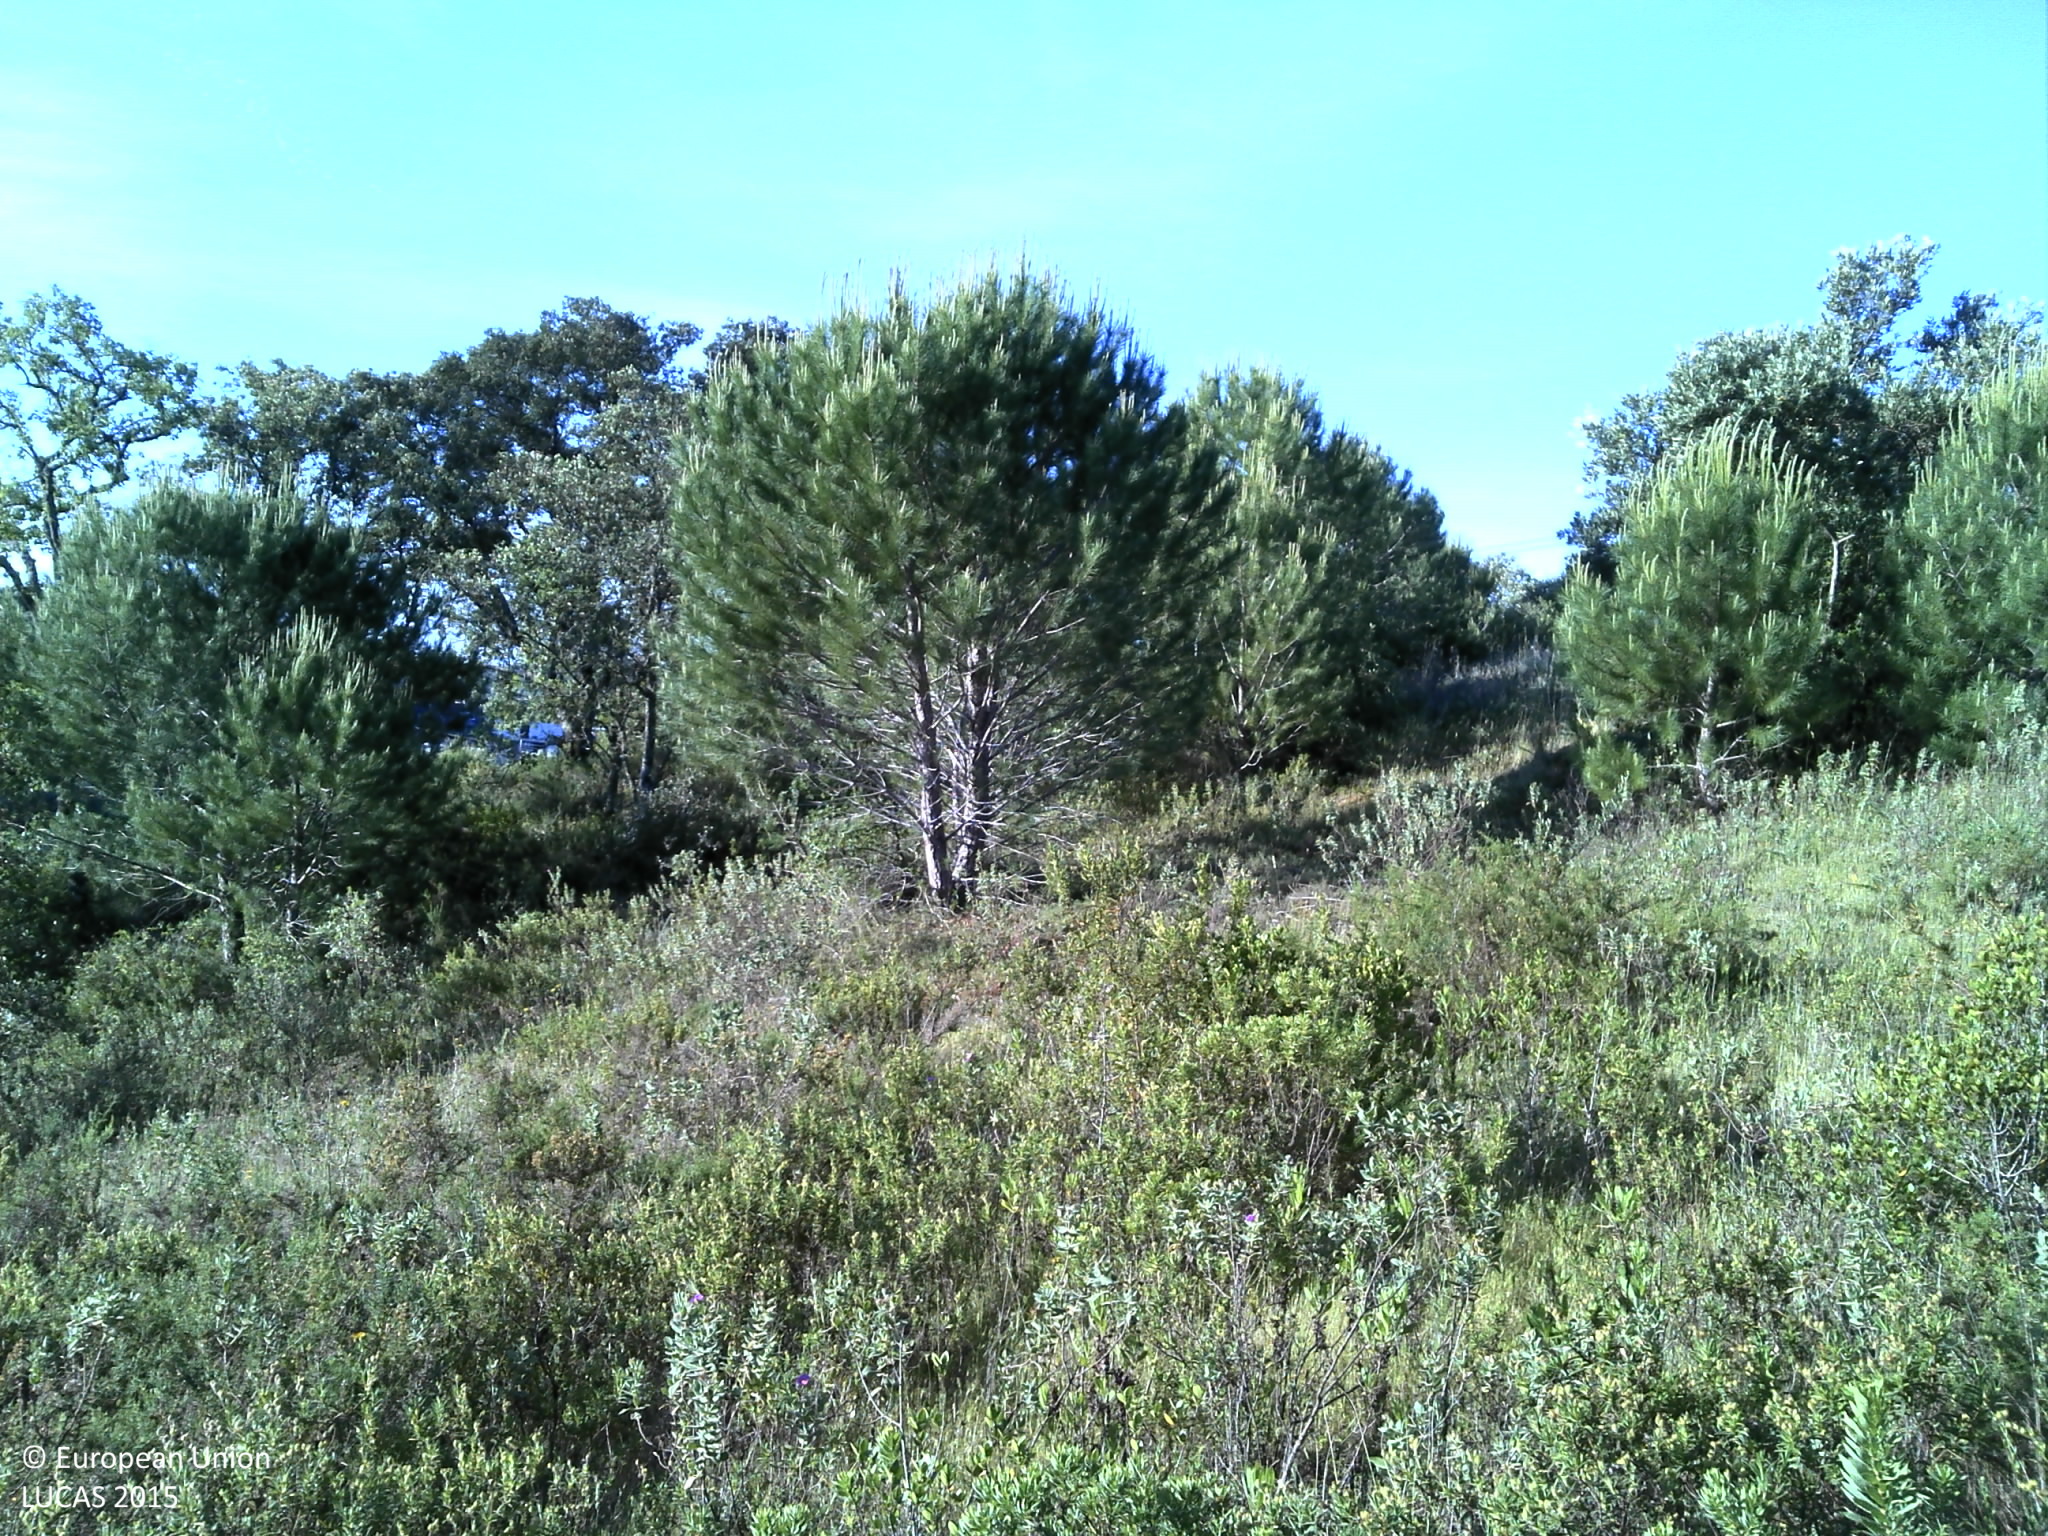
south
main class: Woodland
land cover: Broadleaved woodland
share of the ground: 25 - 50 %
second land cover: Shrubland without tree cover
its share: 25 - 50 %
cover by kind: broadleaved forest trees 50 %, shrubs 20 %, herbaceous plants 20 %, coniferous forest trees 10 %
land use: Forestry
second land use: Fallow land
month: May
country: PT
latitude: 39.6033
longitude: -8.4867
